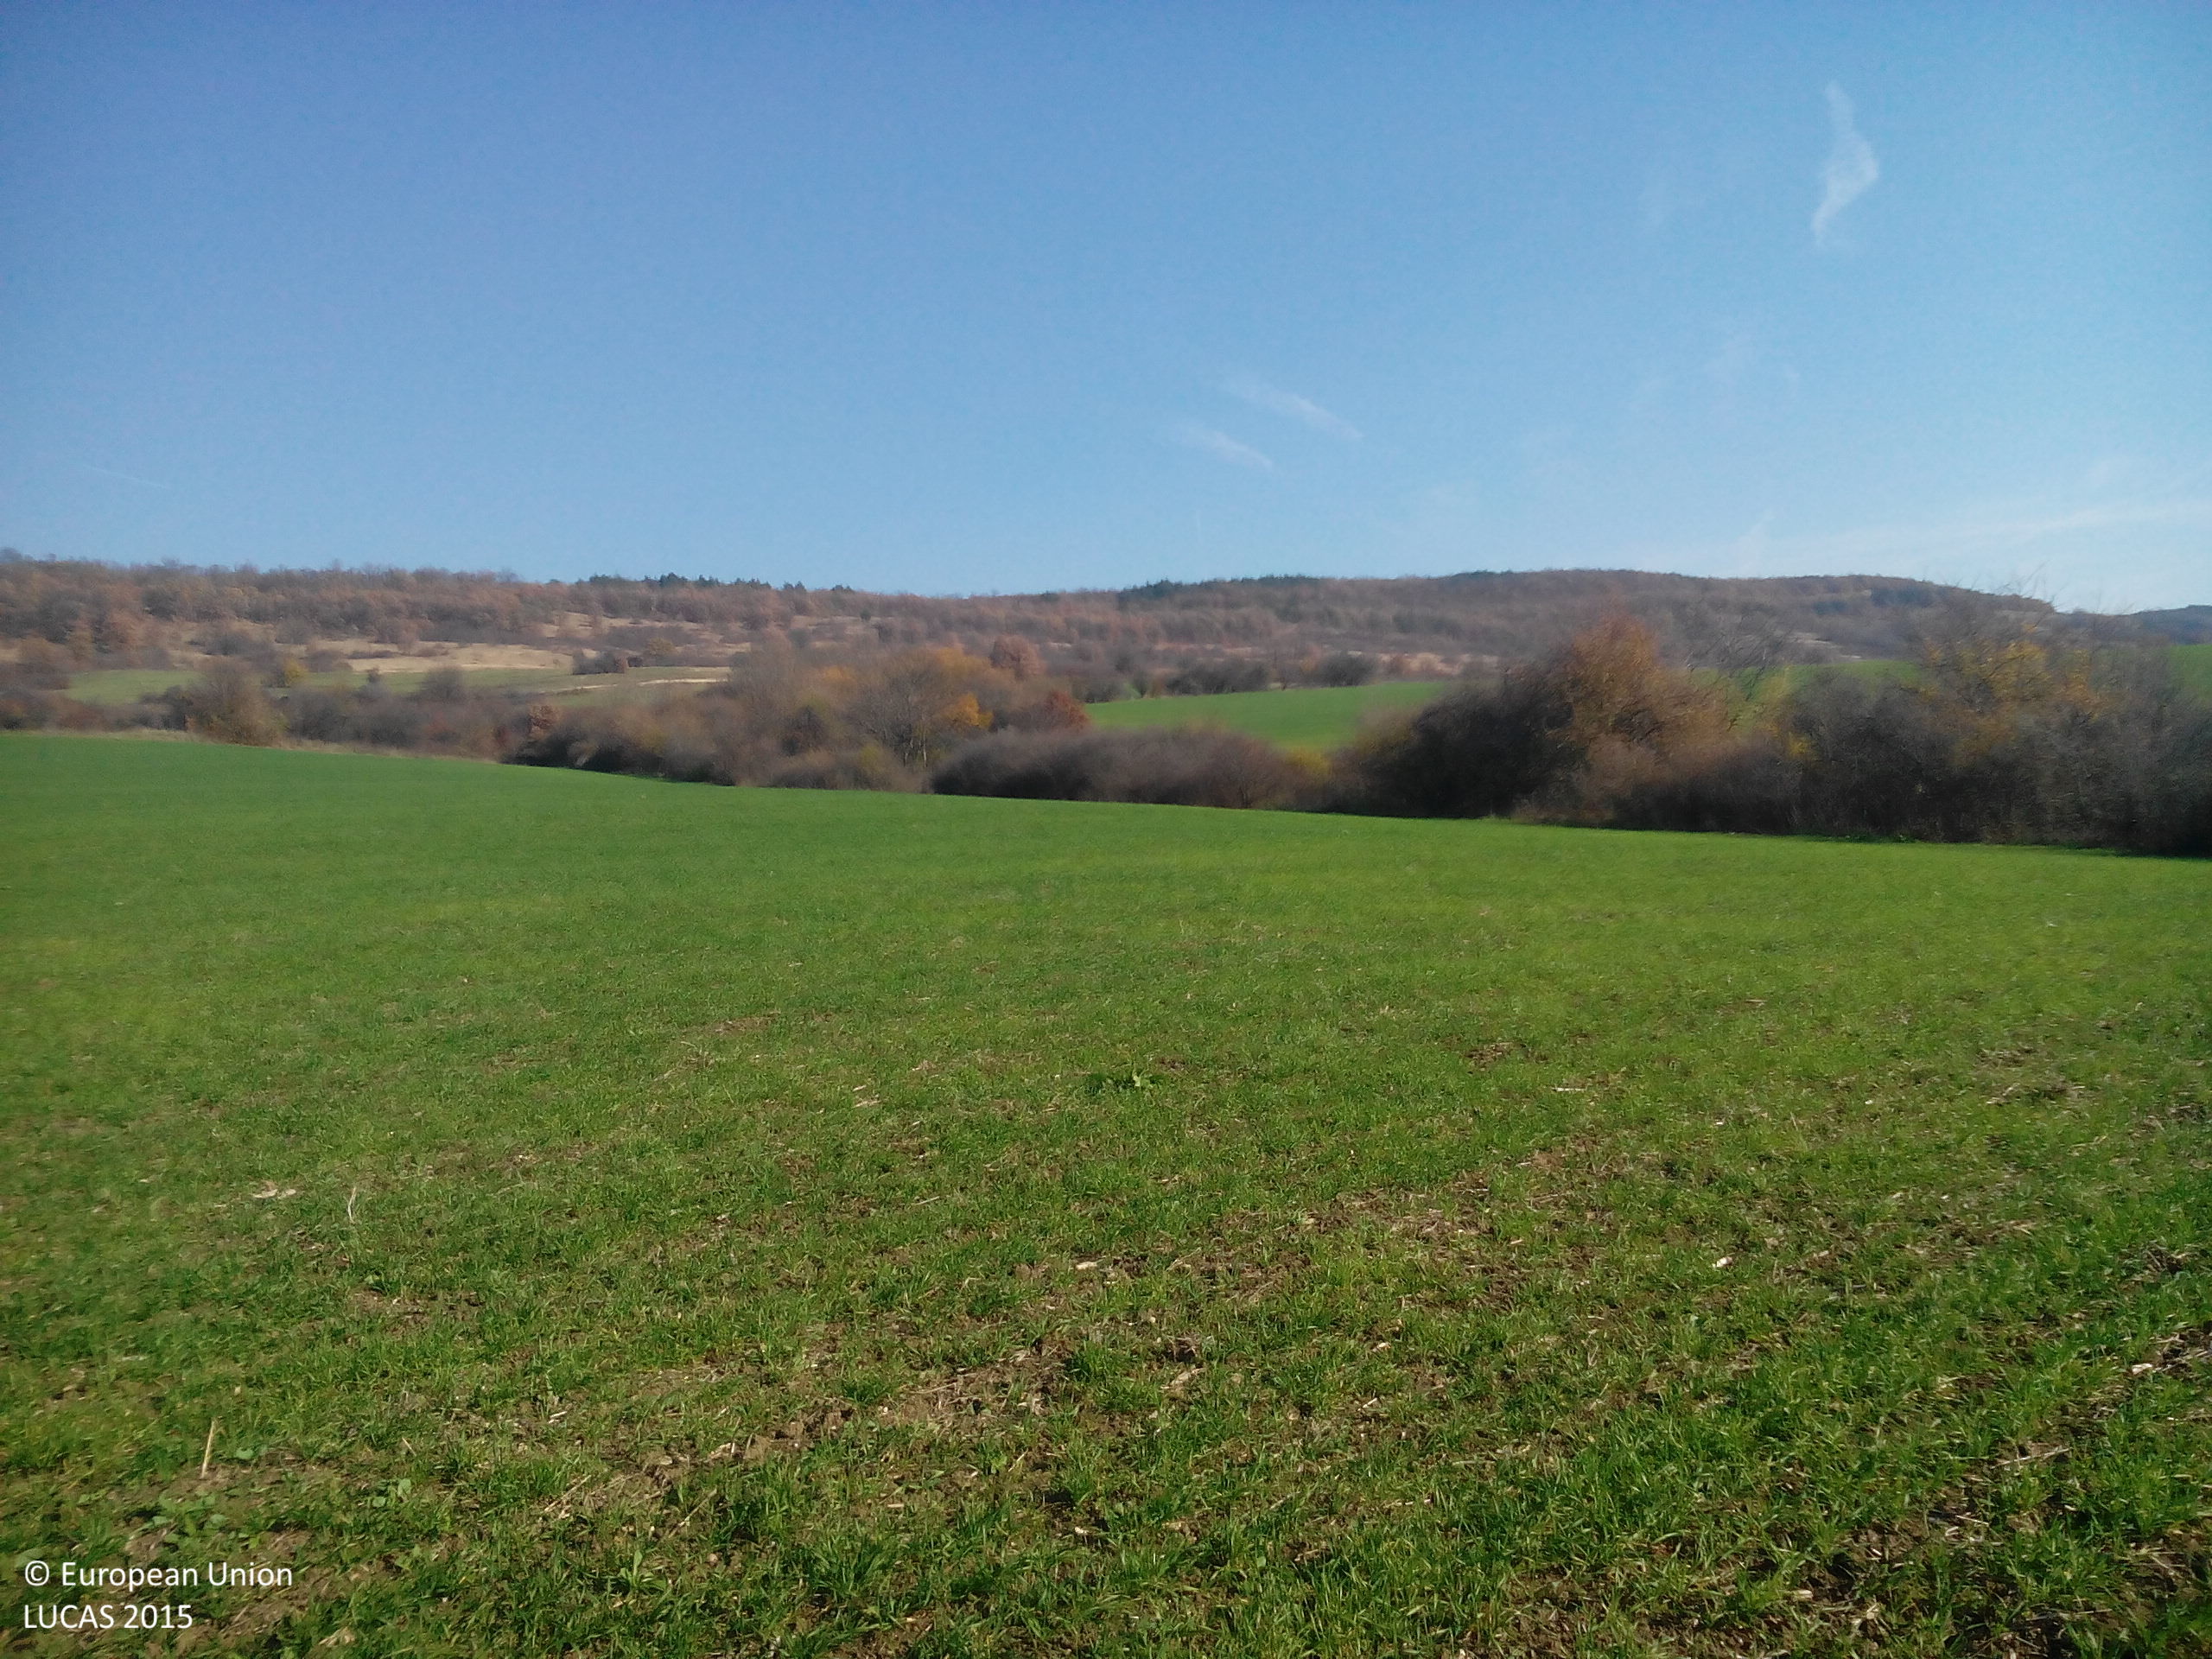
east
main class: Cropland
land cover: Common wheat
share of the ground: 50 - 75 %
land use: Agriculture (excluding fallow land and kitchen gardens)
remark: Harvested field
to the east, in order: Common wheat; Broadleaved woodland; Tracks; Broadleaved woodland; Common wheat
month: November
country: BG
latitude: 43.3111
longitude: 23.8195
